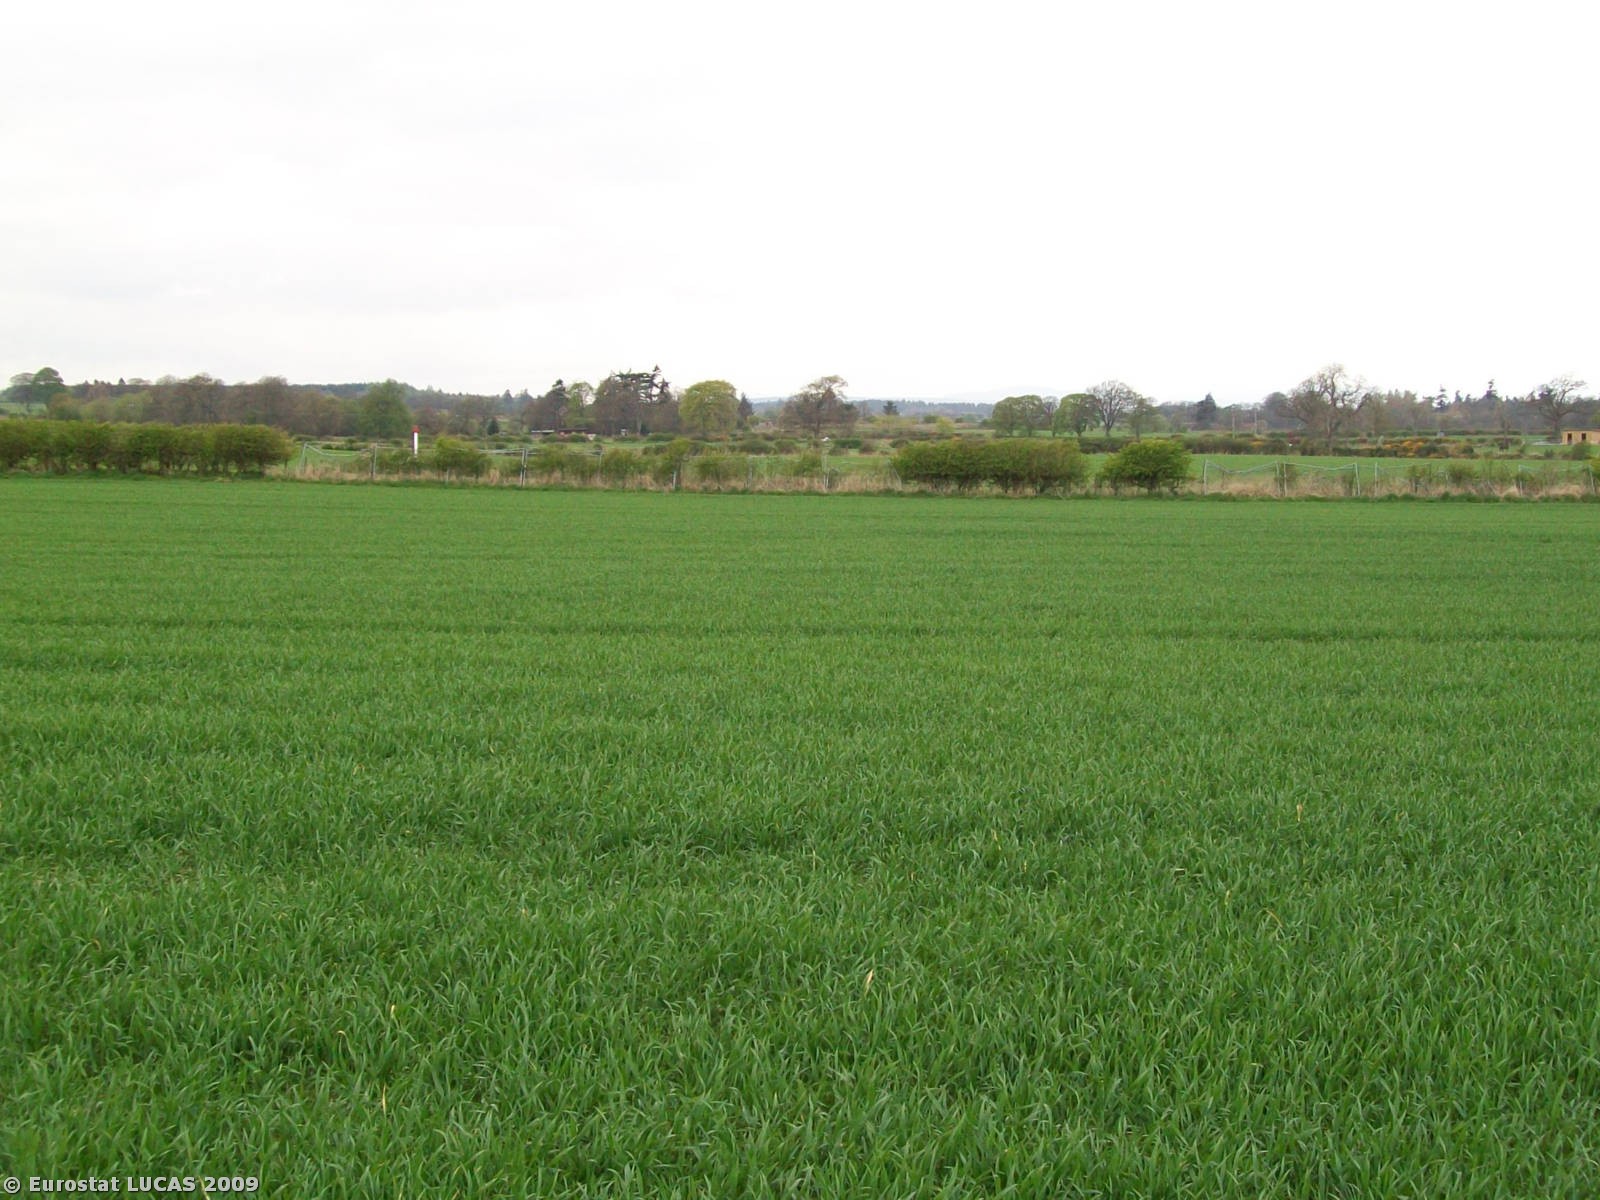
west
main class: Cropland
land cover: Common wheat
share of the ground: 50 - 75 %
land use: Agriculture (excluding fallow land and kitchen gardens)
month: April
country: GB
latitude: 56.3029
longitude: -3.7371
